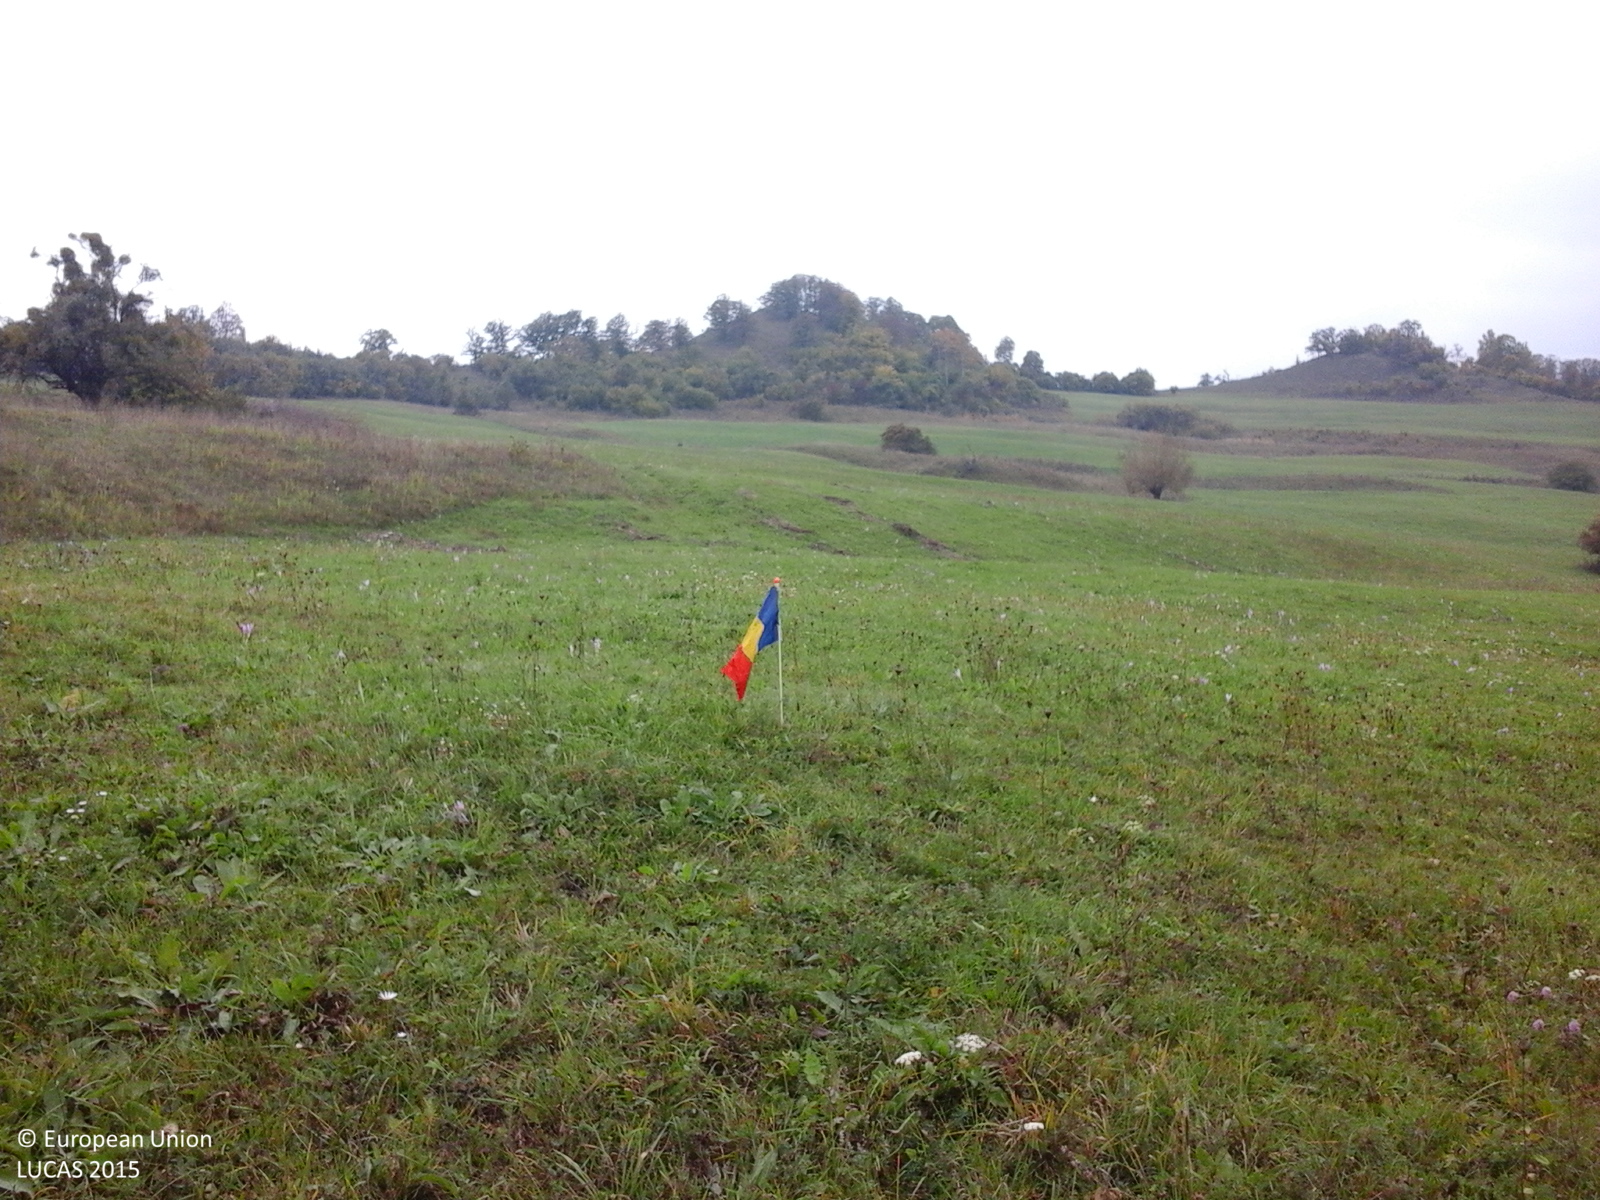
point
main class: Grassland
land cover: Grassland without tree/shrub cover
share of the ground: > 75 %
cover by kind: herbaceous plants 100 %
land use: Agriculture (excluding fallow land and kitchen gardens)
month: October
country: RO
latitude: 46.2601
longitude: 24.8429
